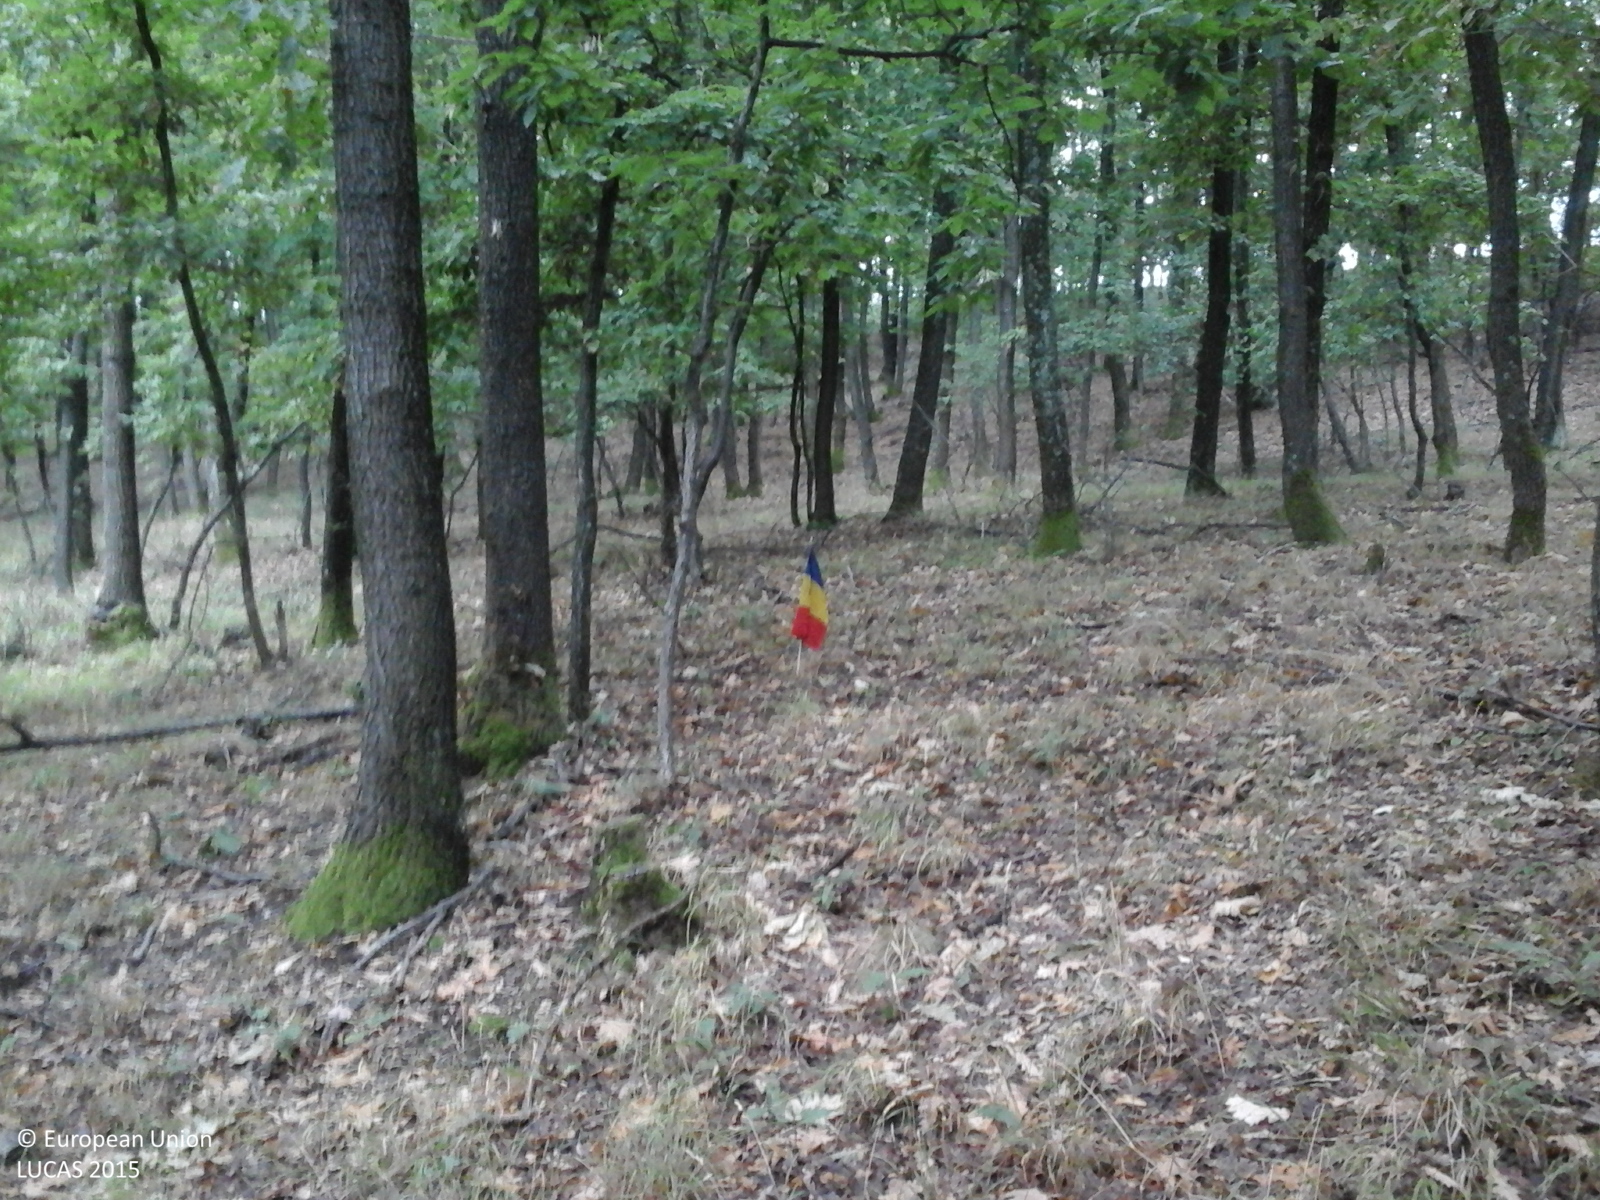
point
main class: Woodland
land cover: Broadleaved woodland
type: acidophilous oak and oak-birch forest
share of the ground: > 75 %
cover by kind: broadleaved forest trees 100 %
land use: Forestry
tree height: > 5 m
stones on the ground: < 10 %
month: August
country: RO
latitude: 44.6050
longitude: 22.8580
